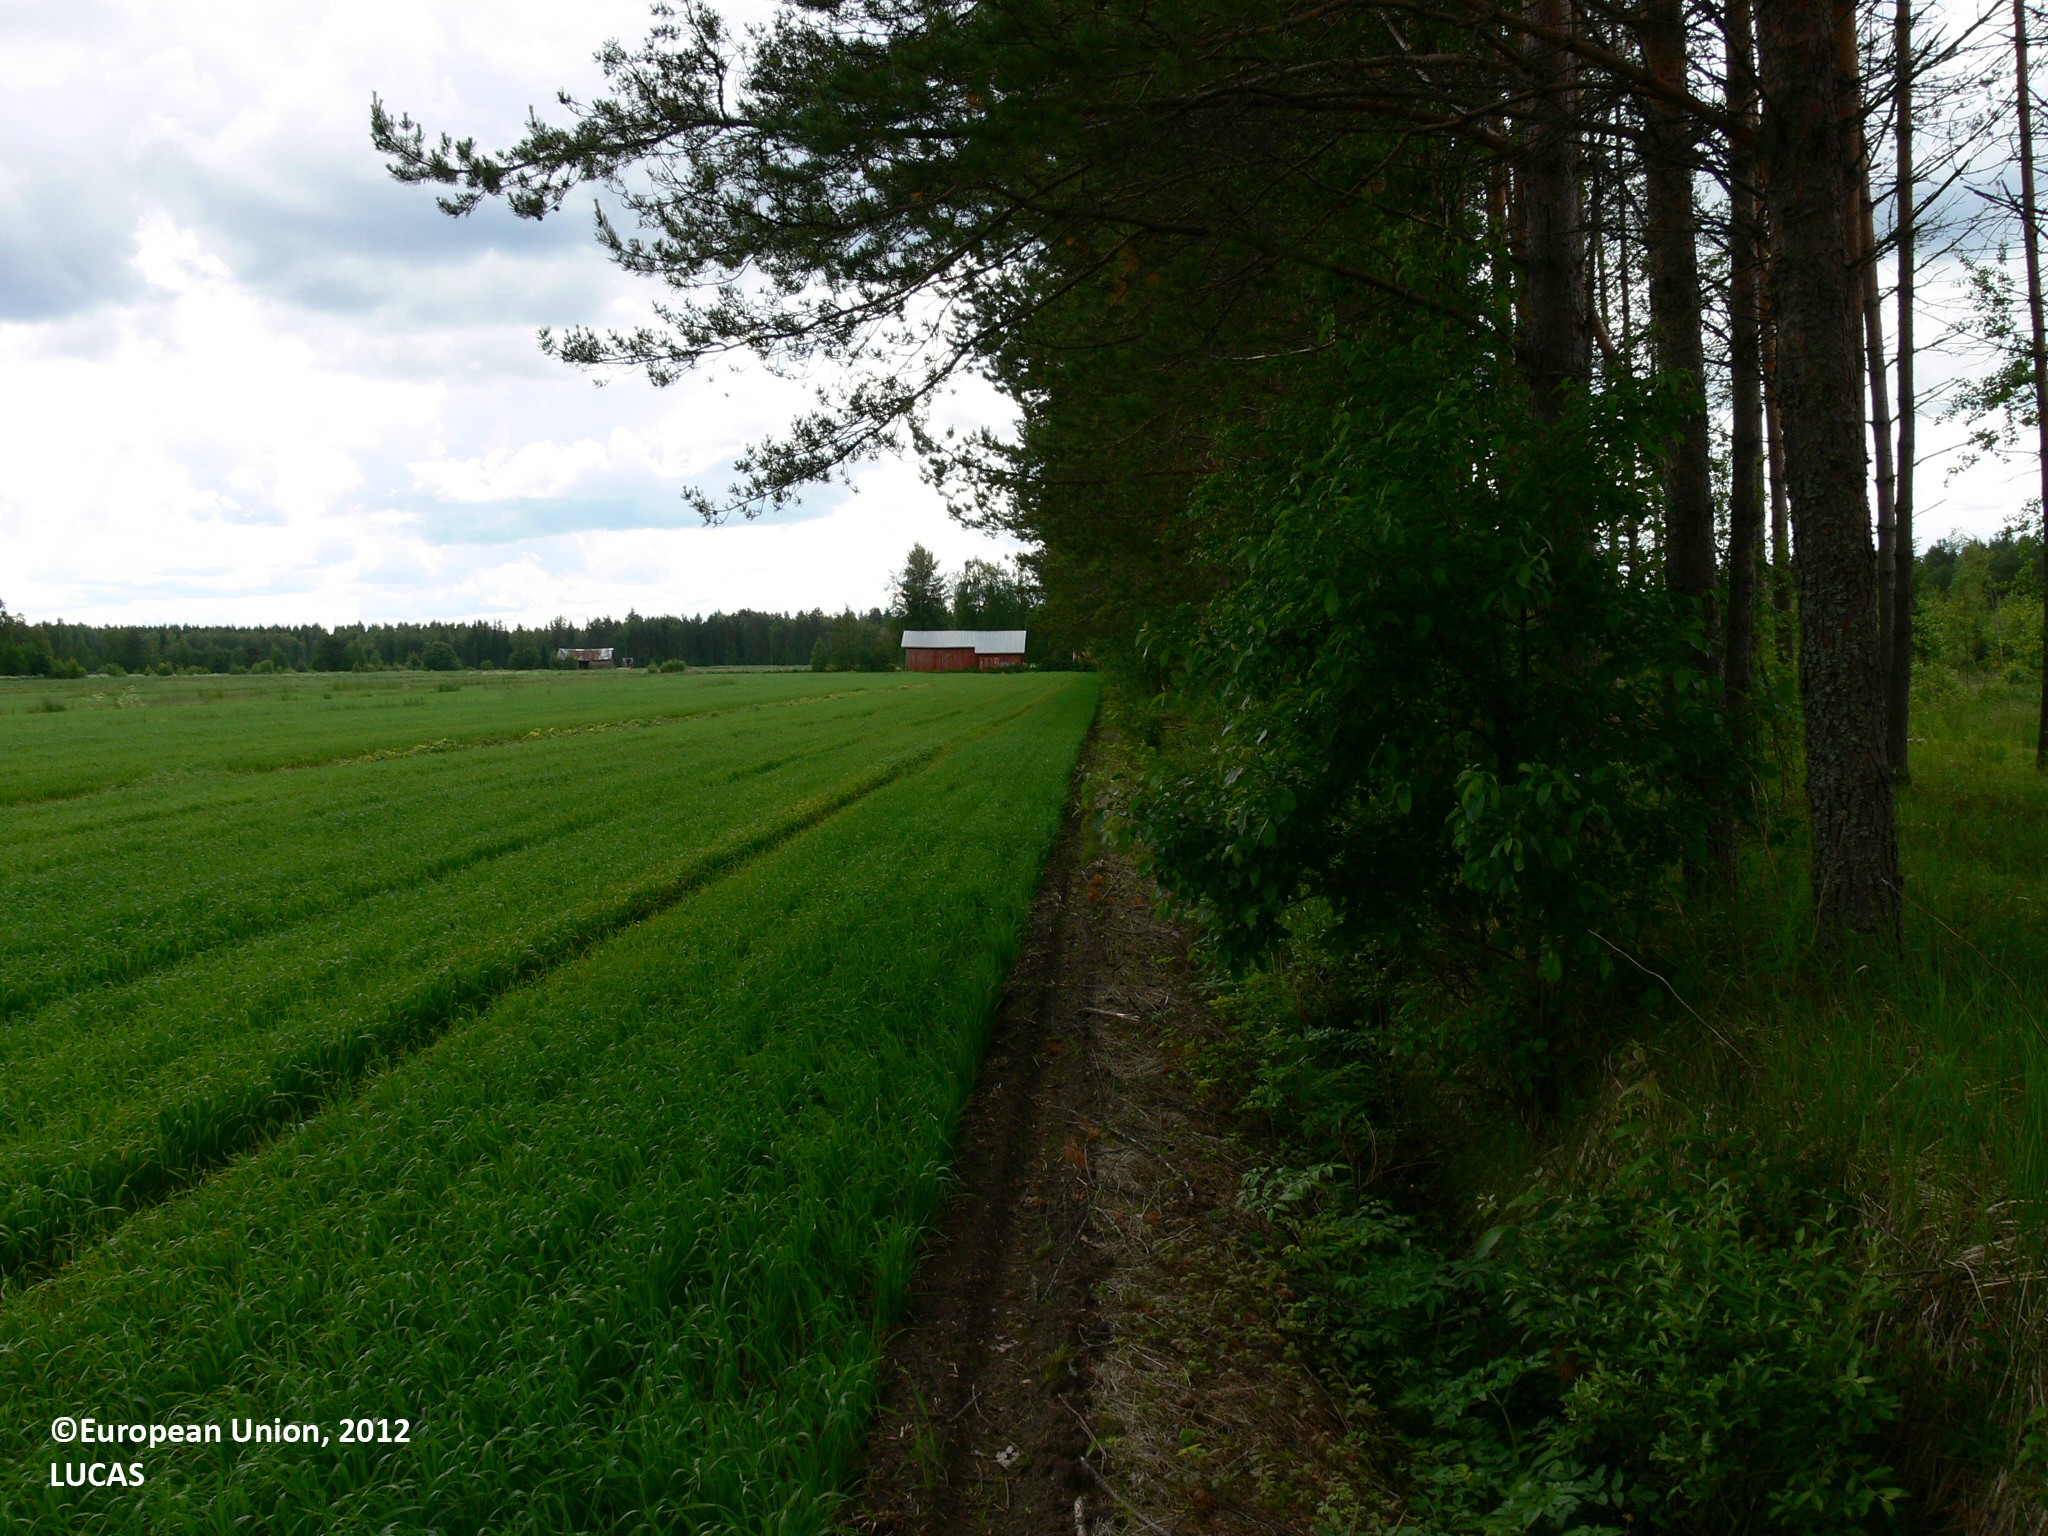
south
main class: Cropland
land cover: Oats
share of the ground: > 75 %
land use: Agriculture (excluding fallow land and kitchen gardens)
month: June
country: FI
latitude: 62.6002
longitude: 29.5427
